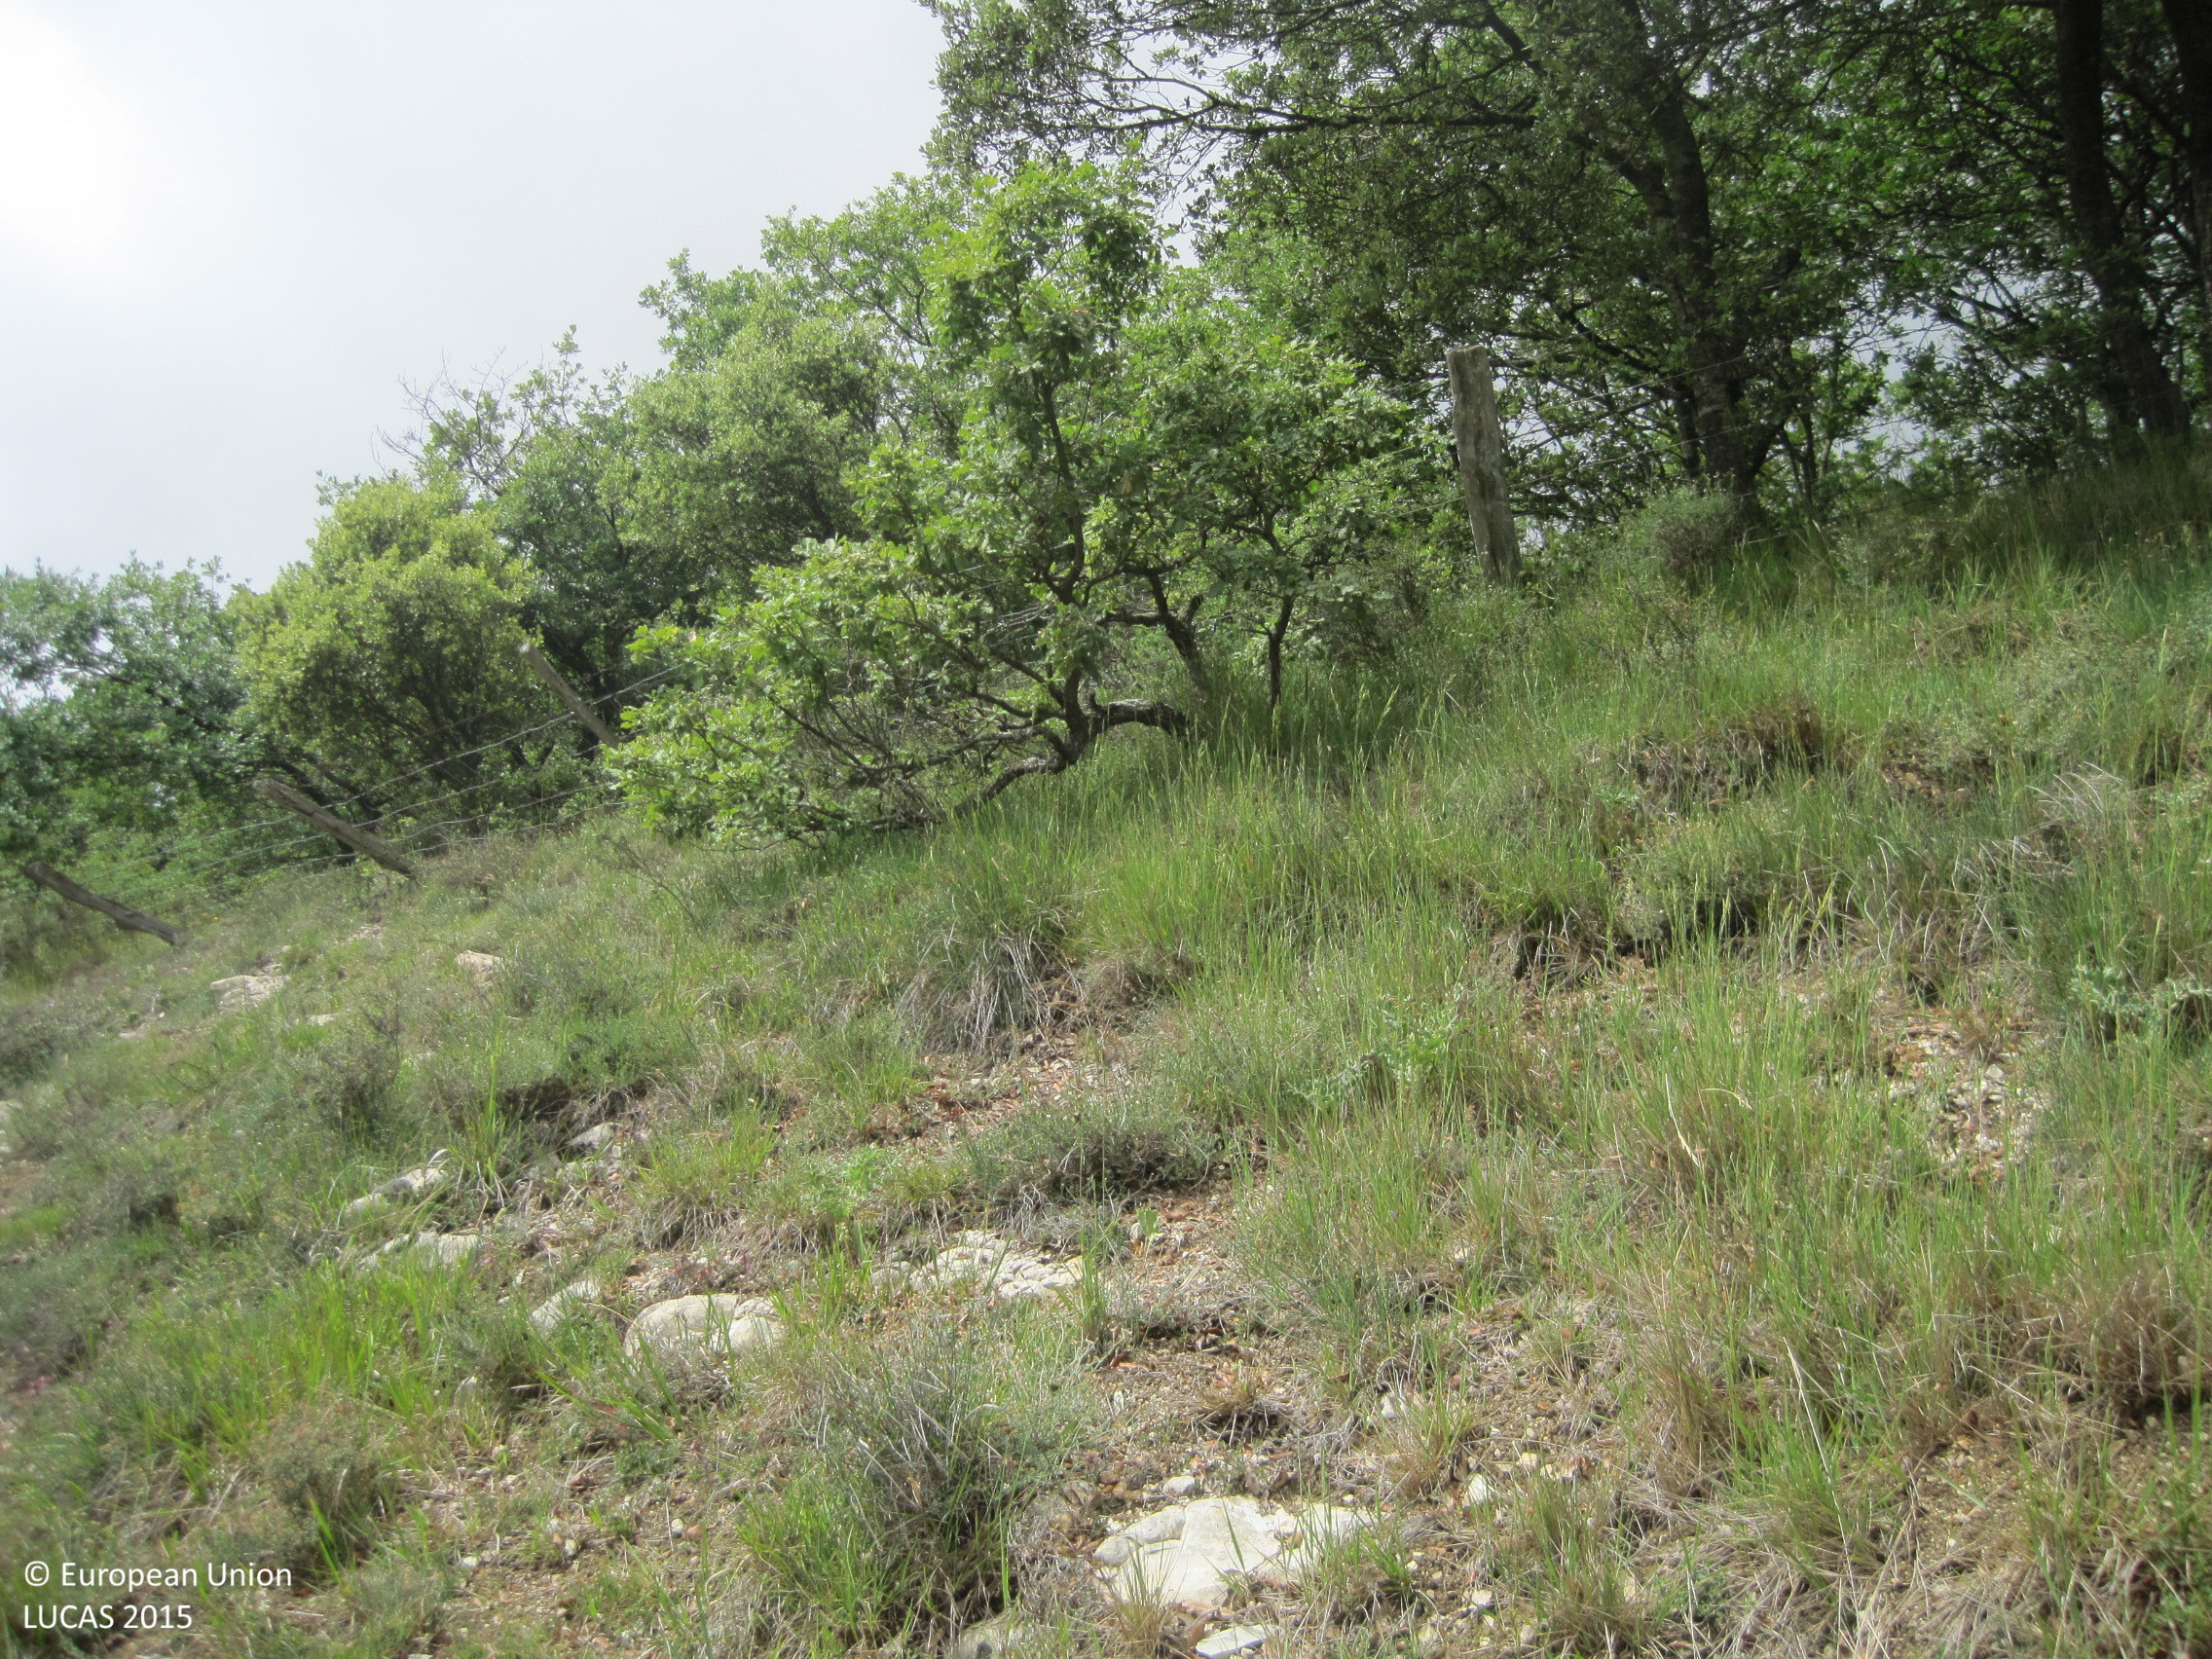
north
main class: Grassland
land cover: Grassland with sparse tree/shrub cover
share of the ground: > 75 %
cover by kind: herbaceous plants 95 %, broadleaved forest trees 5 %
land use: Agriculture (excluding fallow land and kitchen gardens)
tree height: < 5 m
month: June
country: ES
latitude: 42.8960
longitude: -1.7605
